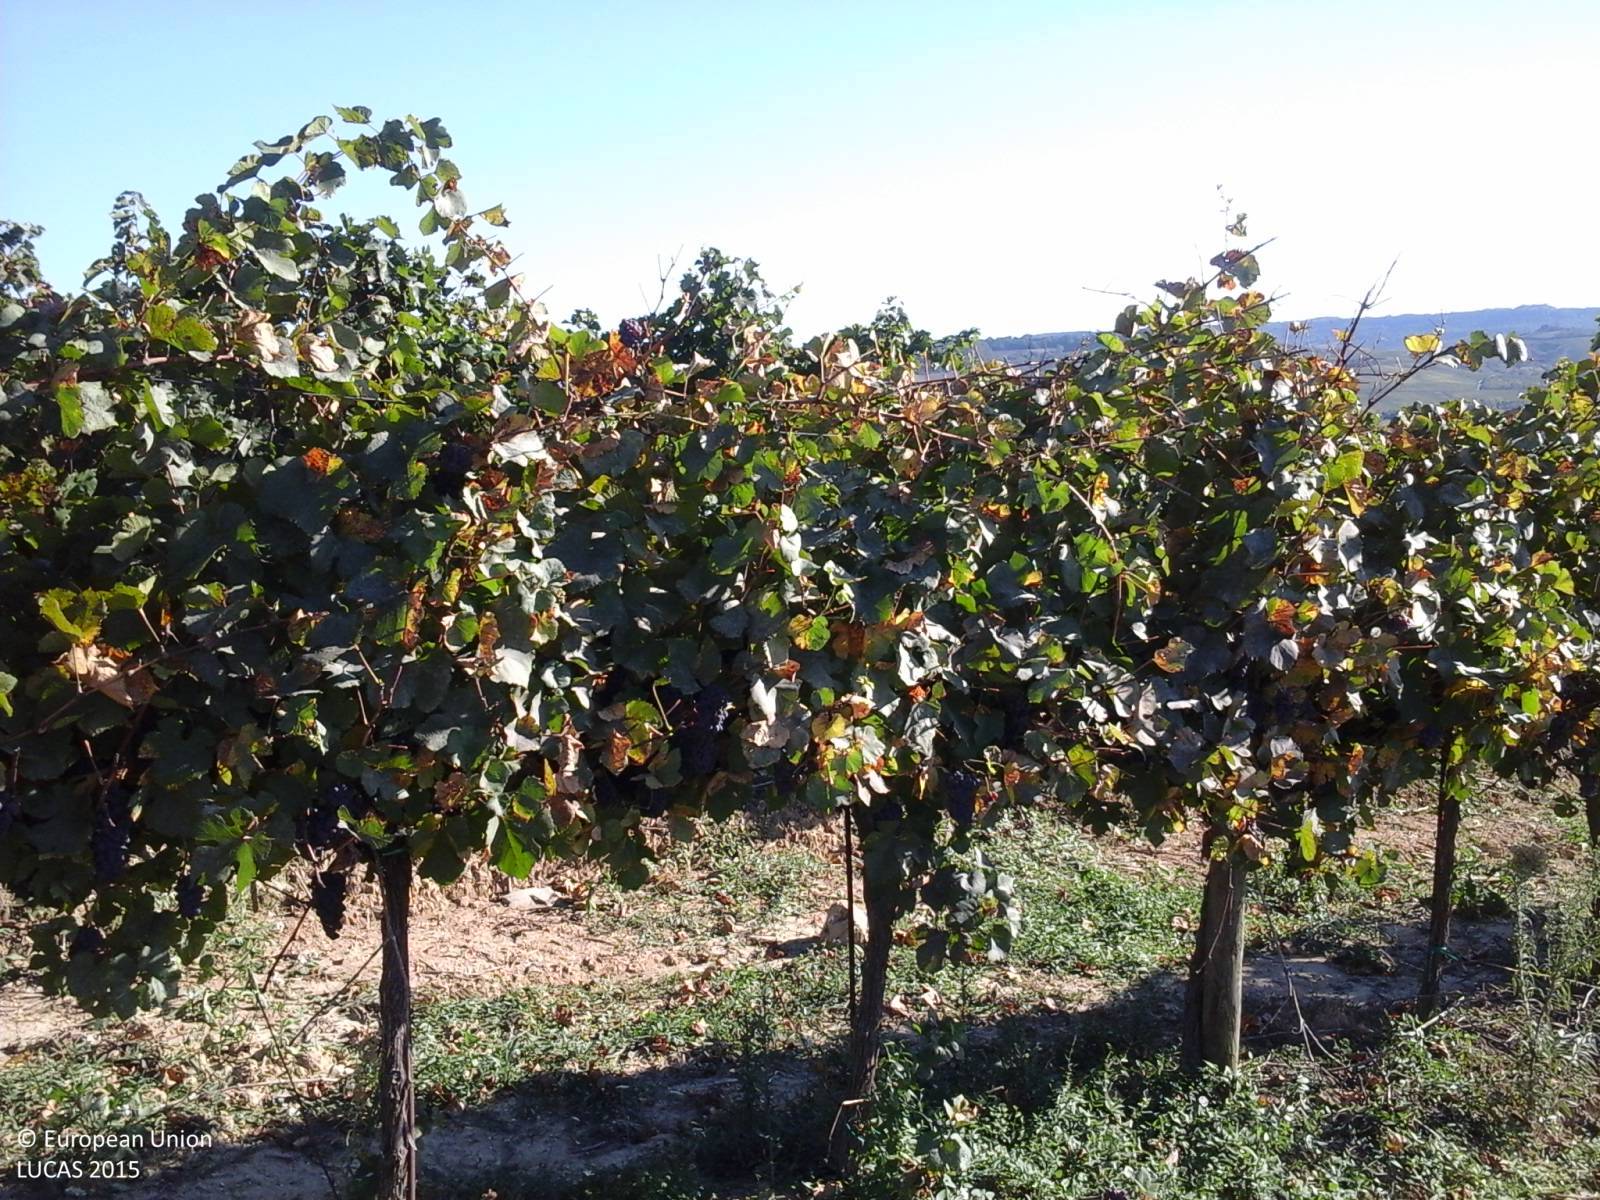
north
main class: Grassland
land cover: Grassland with sparse tree/shrub cover
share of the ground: > 75 %
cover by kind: herbaceous plants 90 %, broadleaved forest trees 5 %, shrubs 5 %
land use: Semi-natural and natural areas not in use
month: September
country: IT
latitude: 42.7776
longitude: 12.0591
